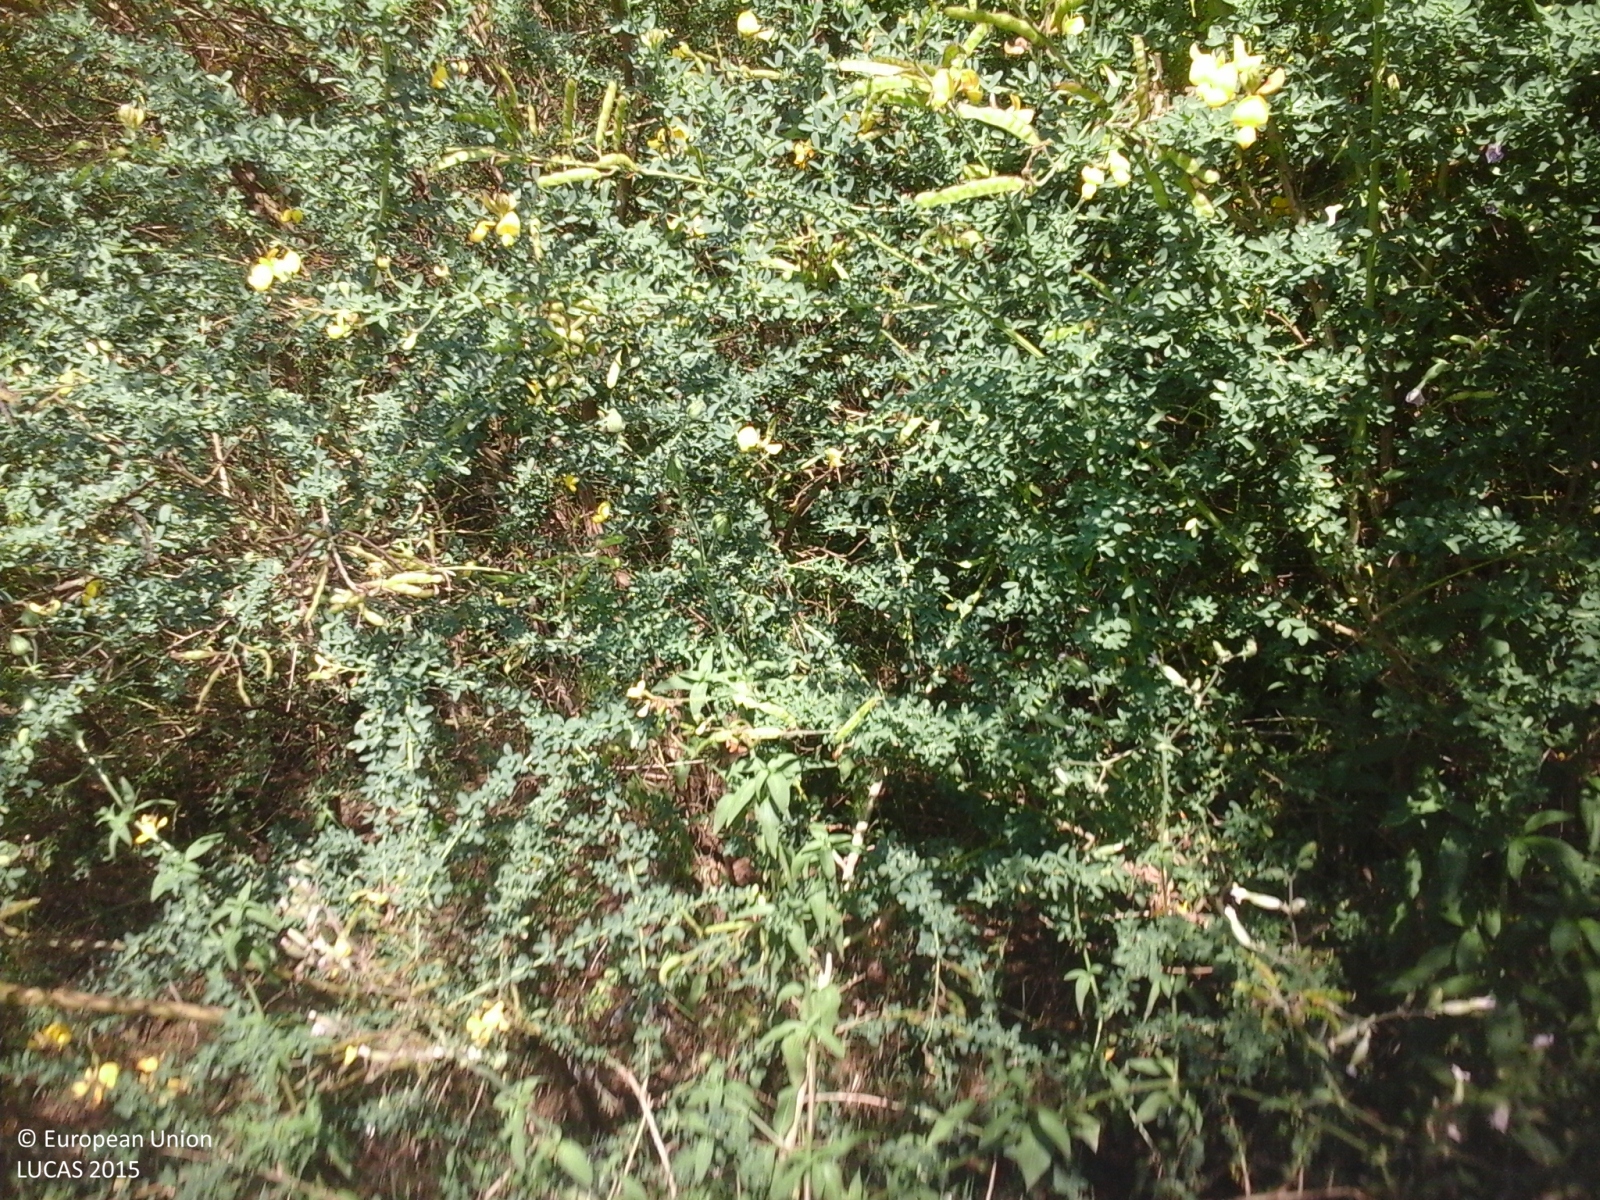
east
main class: Grassland
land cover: Grassland without tree/shrub cover
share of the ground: > 75 %
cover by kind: herbaceous plants 100 %
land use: Agriculture (excluding fallow land and kitchen gardens)
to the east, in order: Grassland without tree/shrub cover; Shrubland without tree cover; Nuts trees; Broadleaved woodland; Shrubland without tree cover; Fences; Paved roads, cycling and walking lanes; Grass margins; Fences; Nuts trees
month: July
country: IT
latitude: 41.8014
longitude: 12.8178
